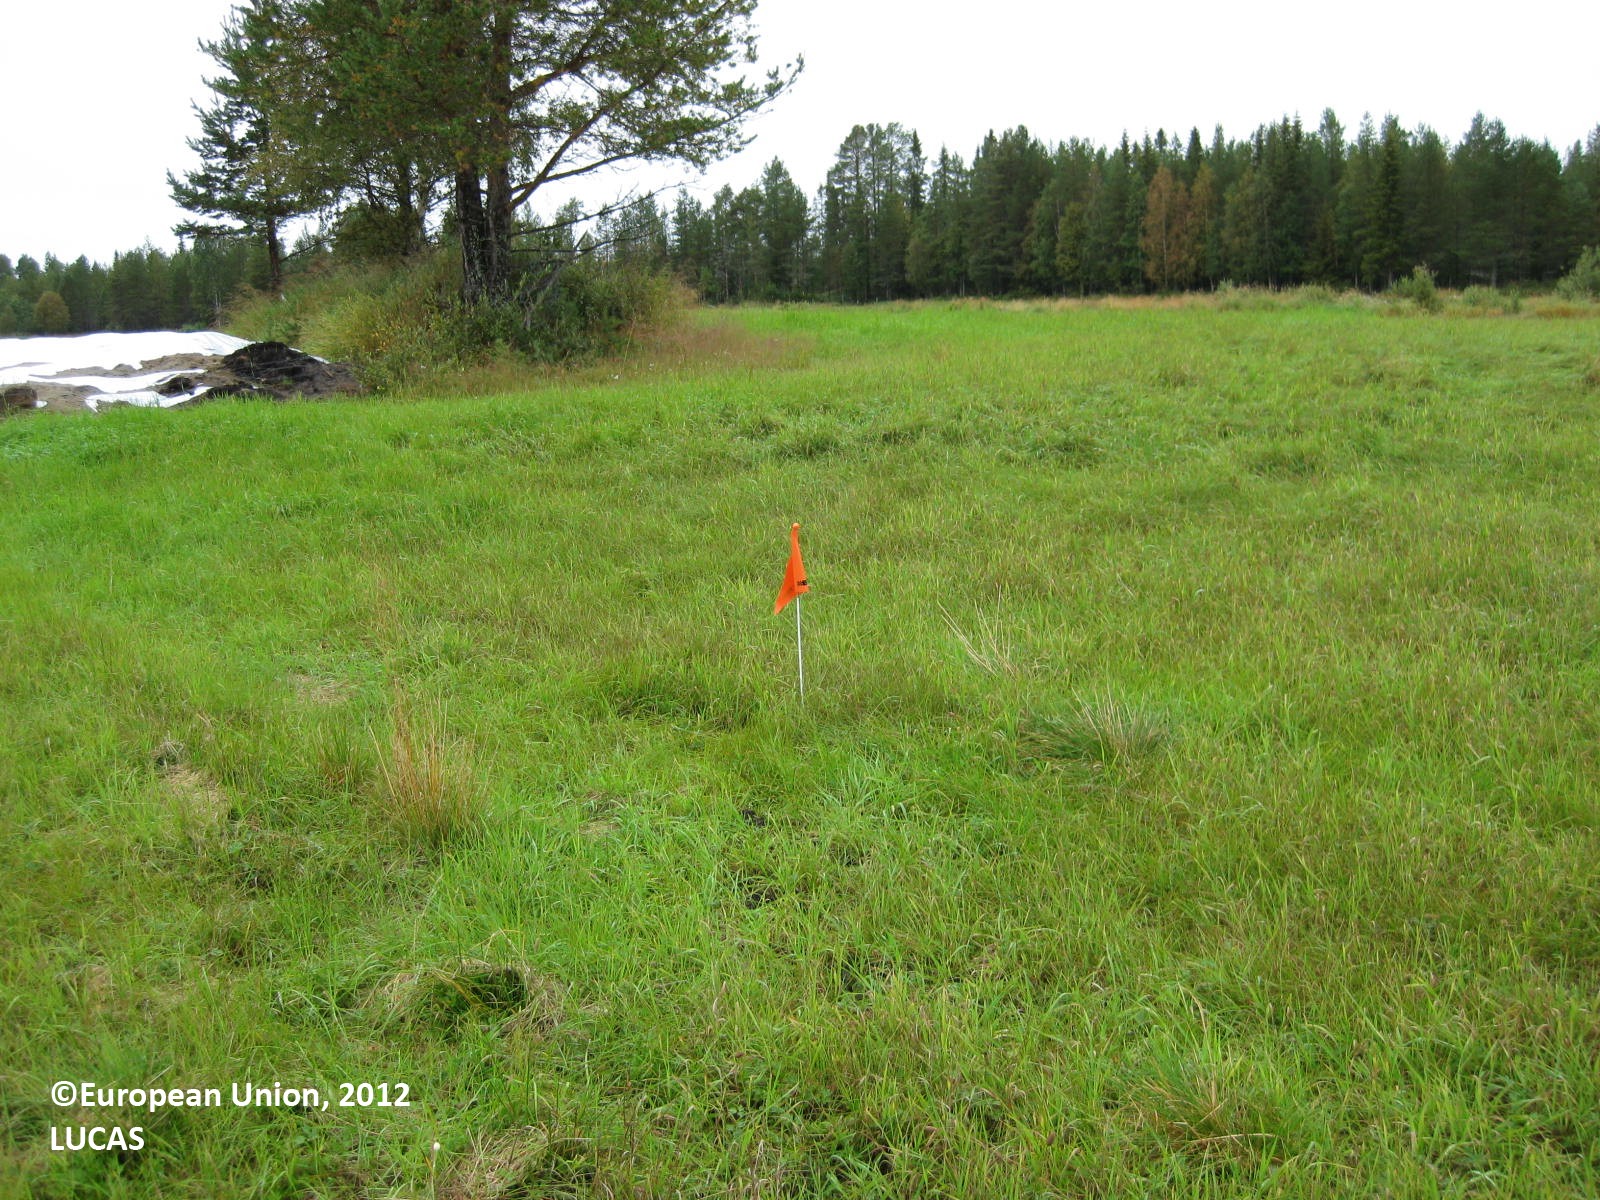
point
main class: Grassland
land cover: Grassland without tree/shrub cover
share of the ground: > 75 %
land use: Agriculture (excluding fallow land and kitchen gardens)
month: August
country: FI
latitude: 66.0293
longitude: 28.6206
